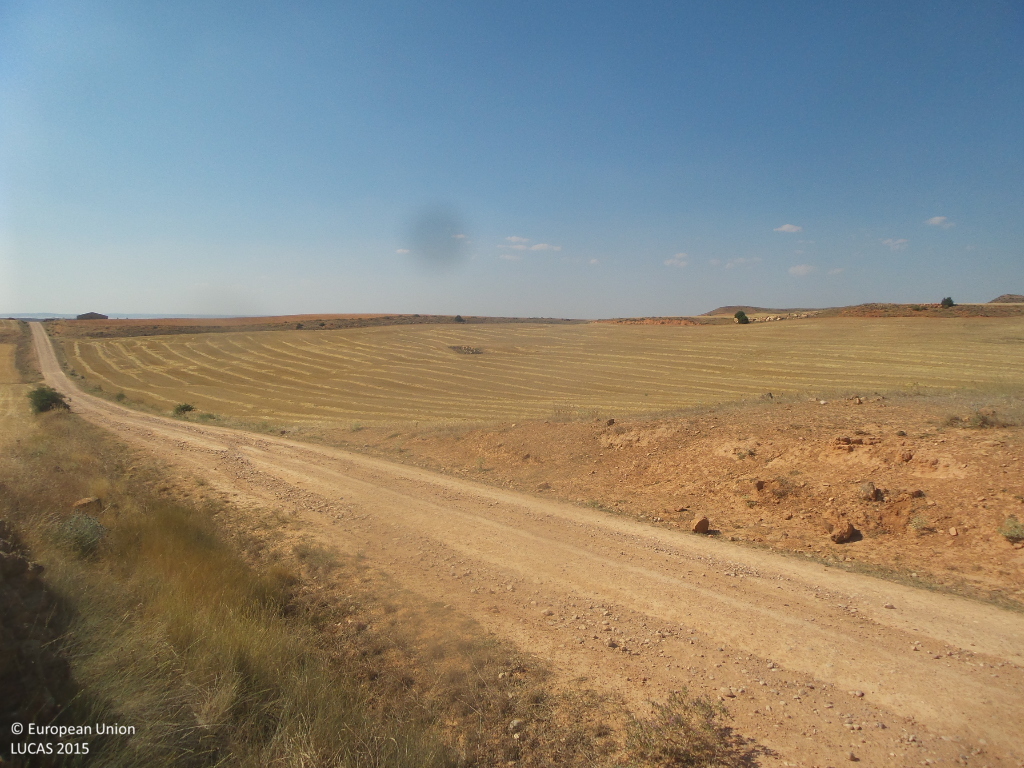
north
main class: Grassland
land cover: Spontaneously vegetated surfaces
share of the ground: > 75 %
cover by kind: herbaceous plants 90 %, unconsolidated bare surface 10 %
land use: Semi-natural and natural areas not in use
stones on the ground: < 10 %
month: July
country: ES
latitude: 41.1950
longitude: -2.1068
